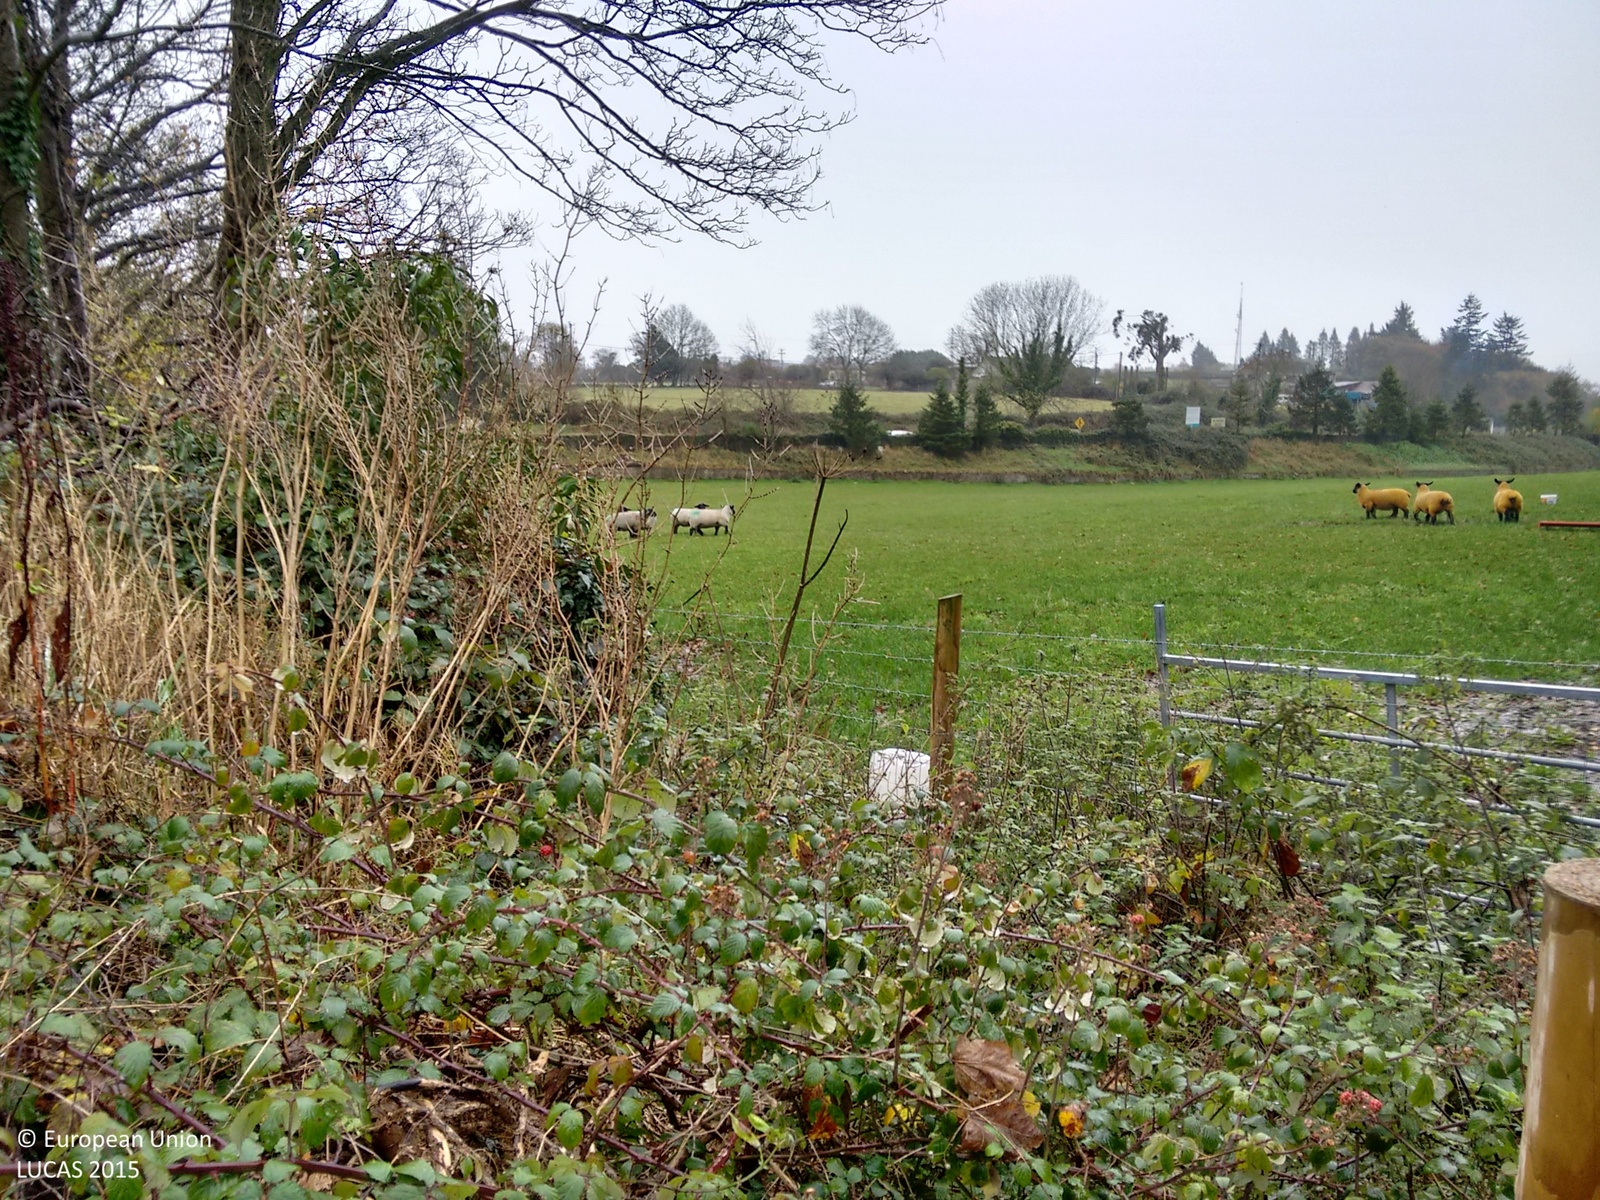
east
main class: Grassland
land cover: Grassland without tree/shrub cover
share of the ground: > 75 %
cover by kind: herbaceous plants 60 %
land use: Agriculture (excluding fallow land and kitchen gardens)
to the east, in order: Grassland without tree/shrub cover; Artificial constructions; Managed hedges; Grass margins; Paved roads, cycling and walking lanes; Grass margins; Shrubland without tree cover; Electric lines; Grassland without tree/shrub cover; Electric lines; Grassland without tree/shrub cover; Fences; Lines of trees; Fences; Grassland without tree/shrub cover
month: November
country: IE
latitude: 53.0671
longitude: -6.0990
